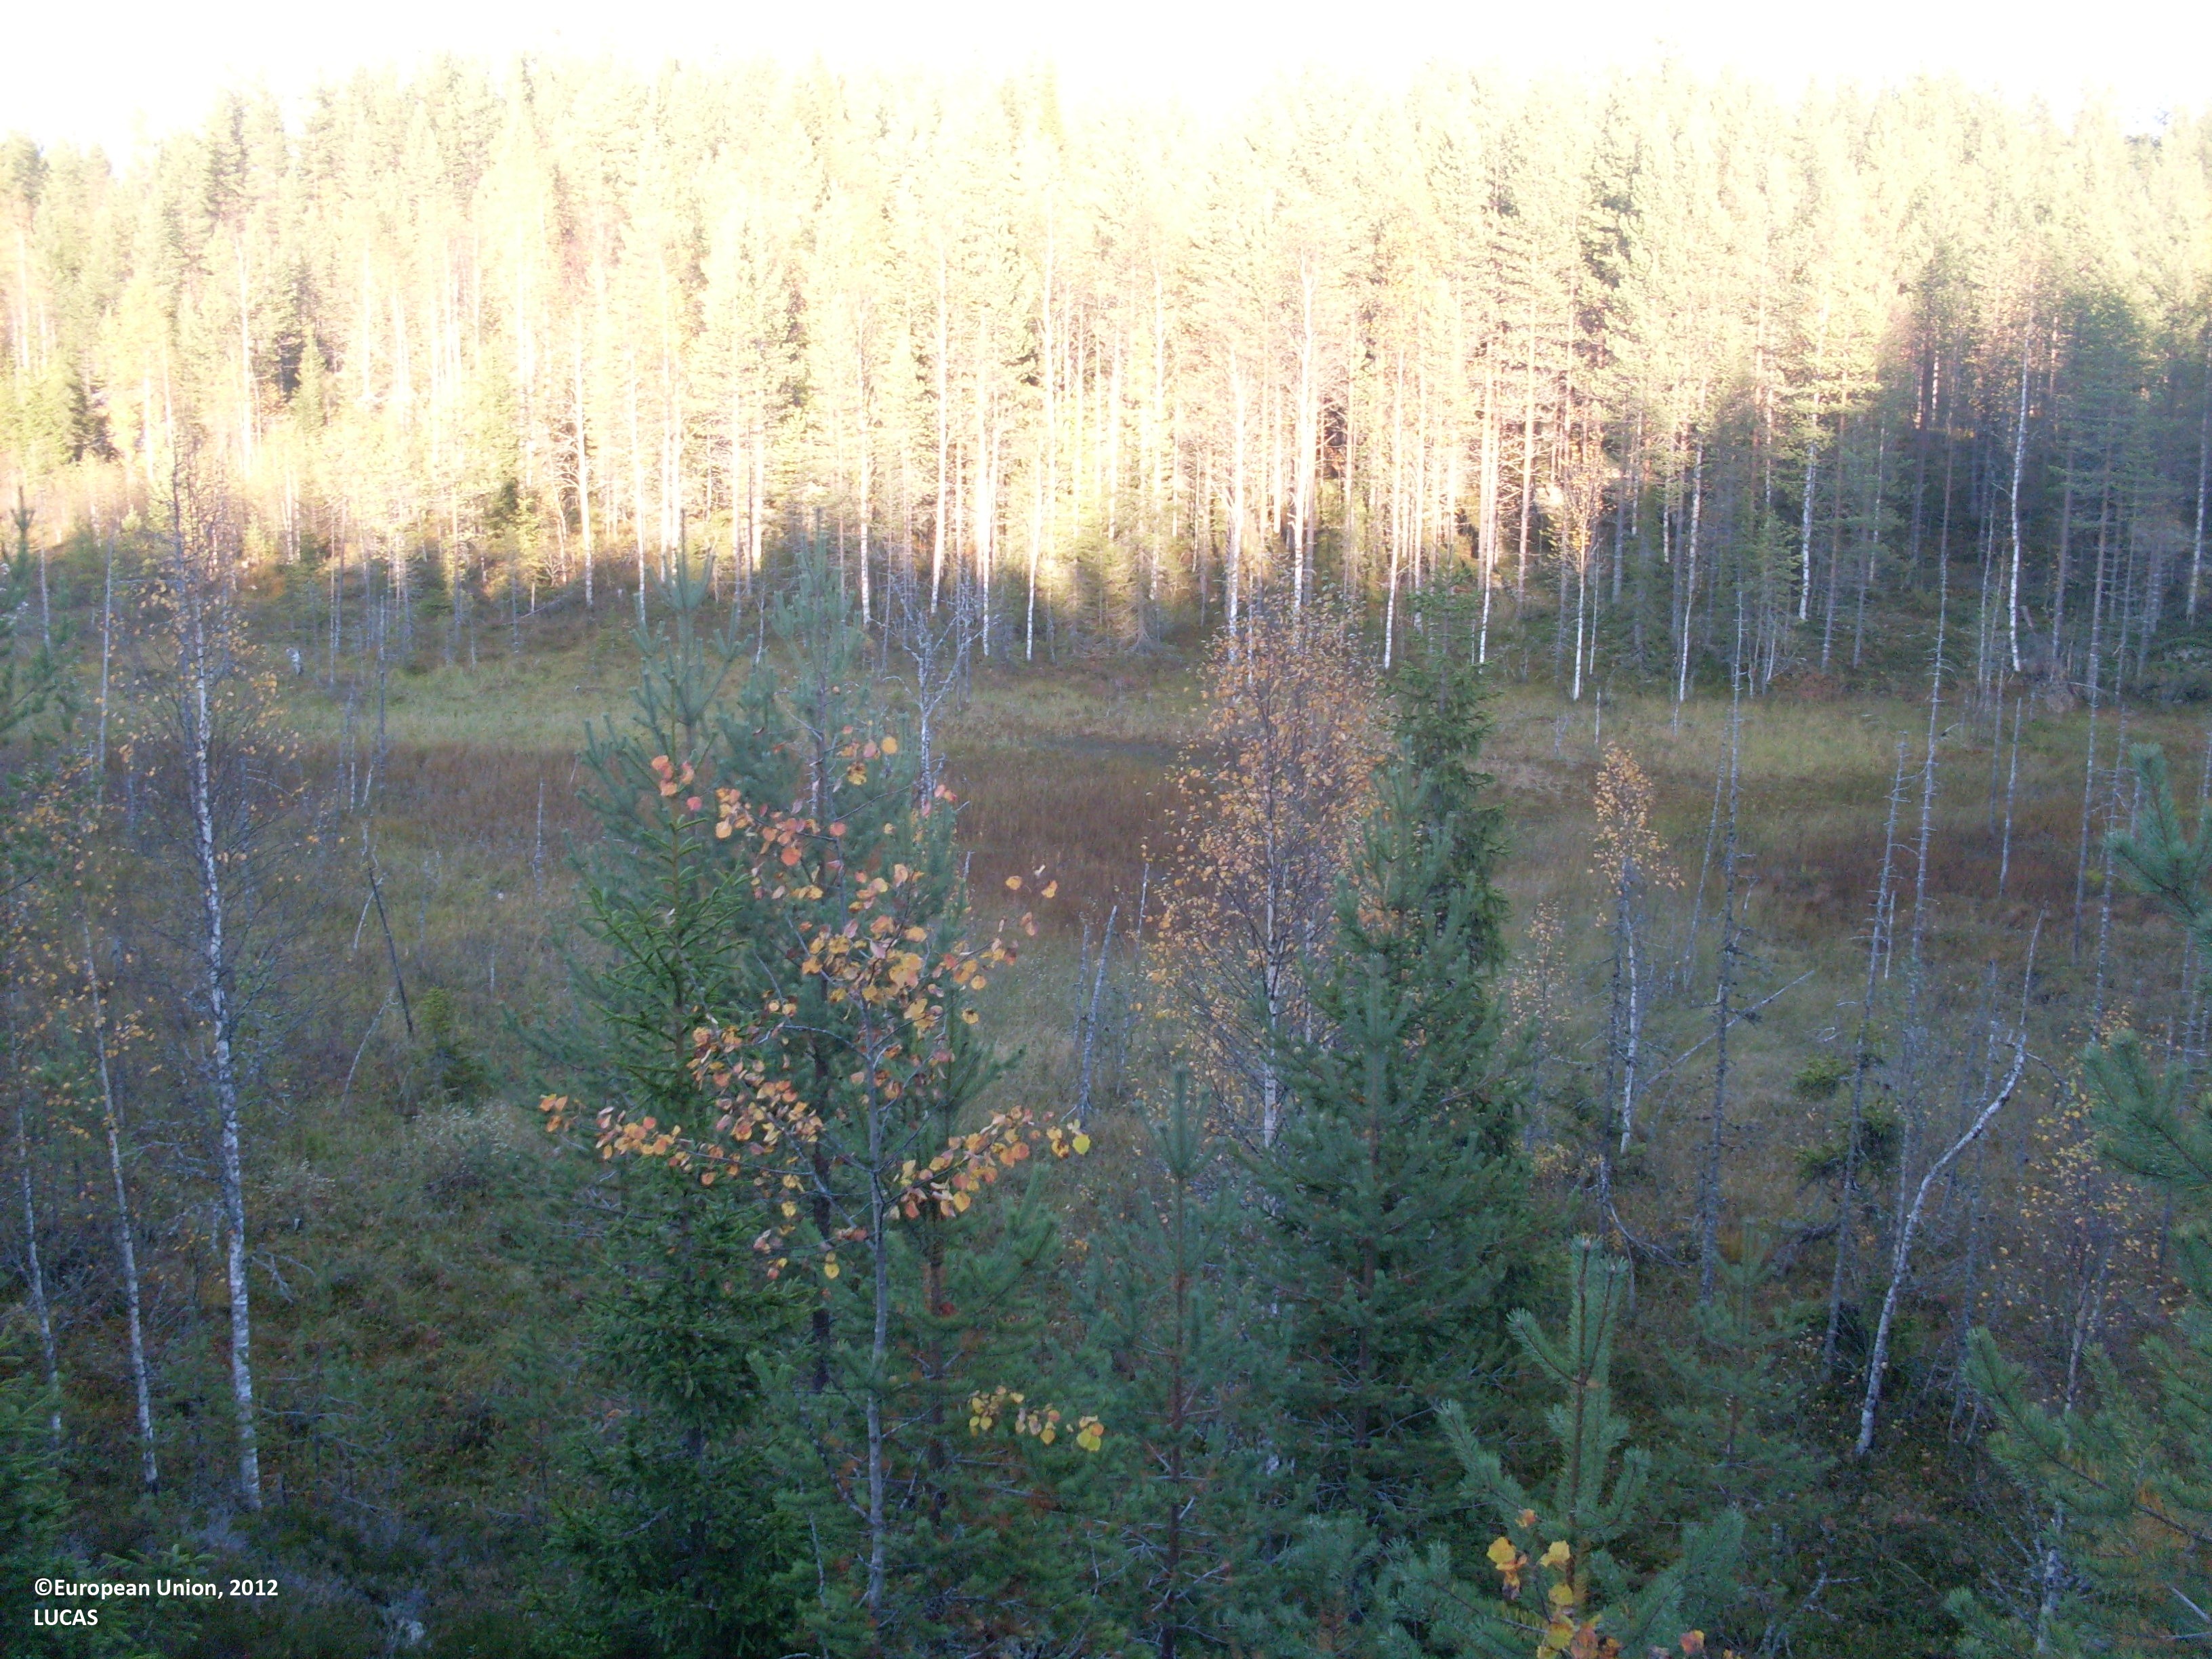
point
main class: Woodland
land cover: Pine dominated mixed woodland
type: boreal forest
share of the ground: > 75 %
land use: Forestry
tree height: > 5 m
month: September
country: FI
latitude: 64.2130
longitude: 28.6238
